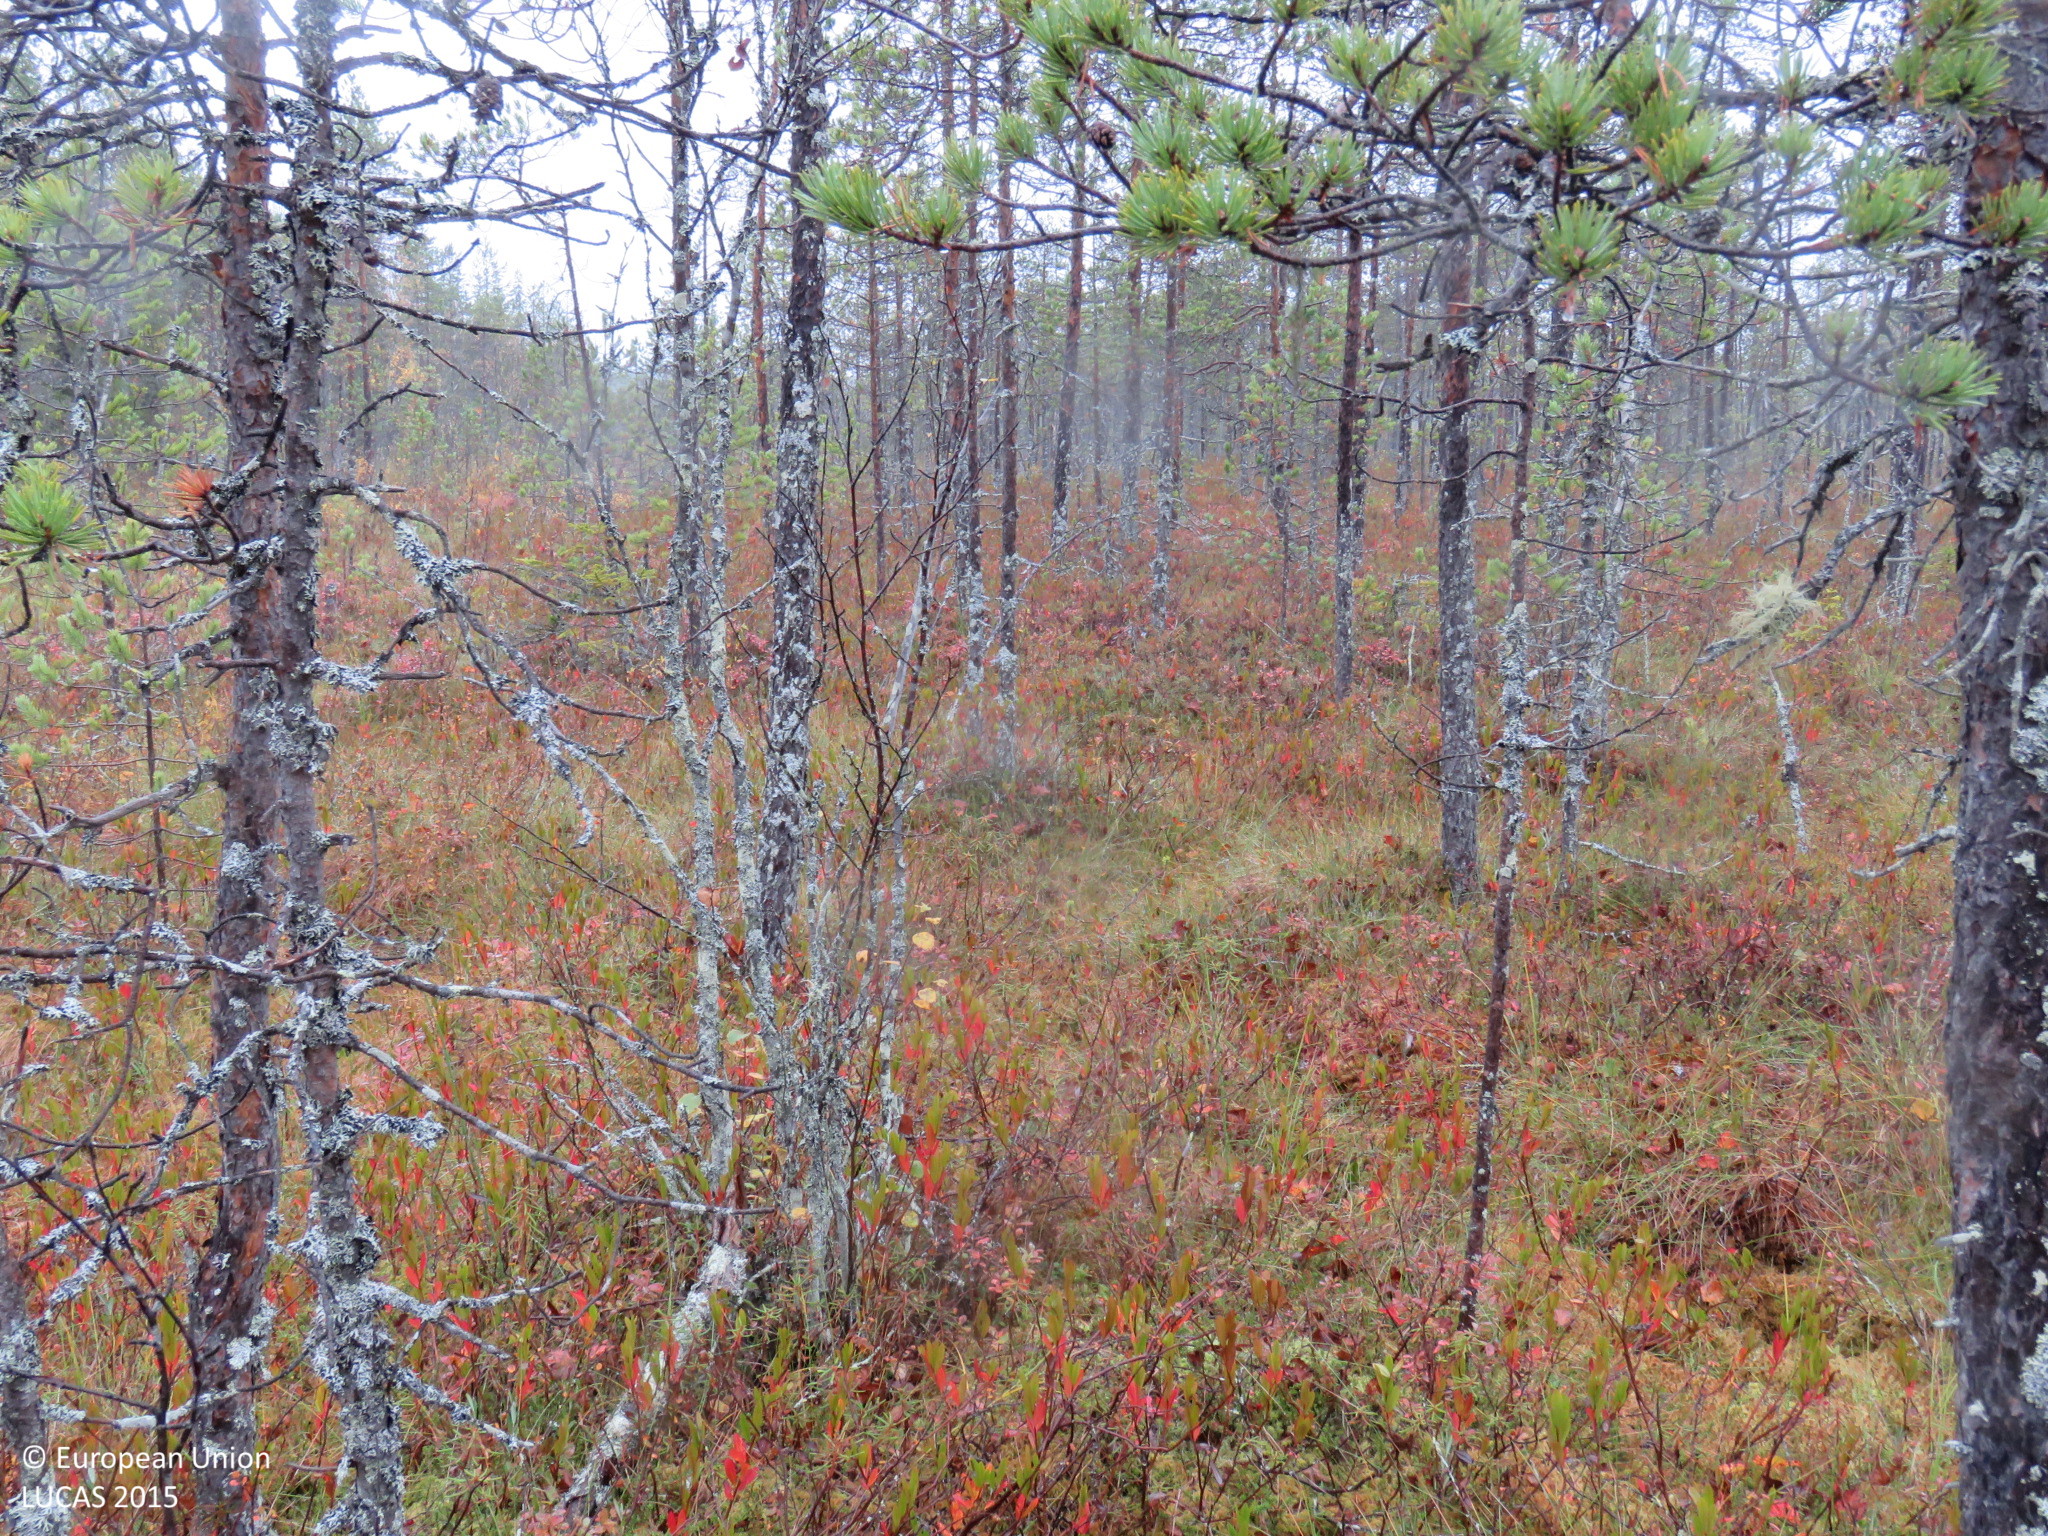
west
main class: Woodland
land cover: Pine dominated coniferous woodland
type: mire and swamp forests
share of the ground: 50 - 75 %
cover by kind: coniferous forest trees 70 %, shrubs 15 %, herbaceous plants 10 %, lichens and mosses 5 %
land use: Semi-natural and natural areas not in use
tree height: < 5 m
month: September
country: FI
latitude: 64.8653
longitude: 26.6351
